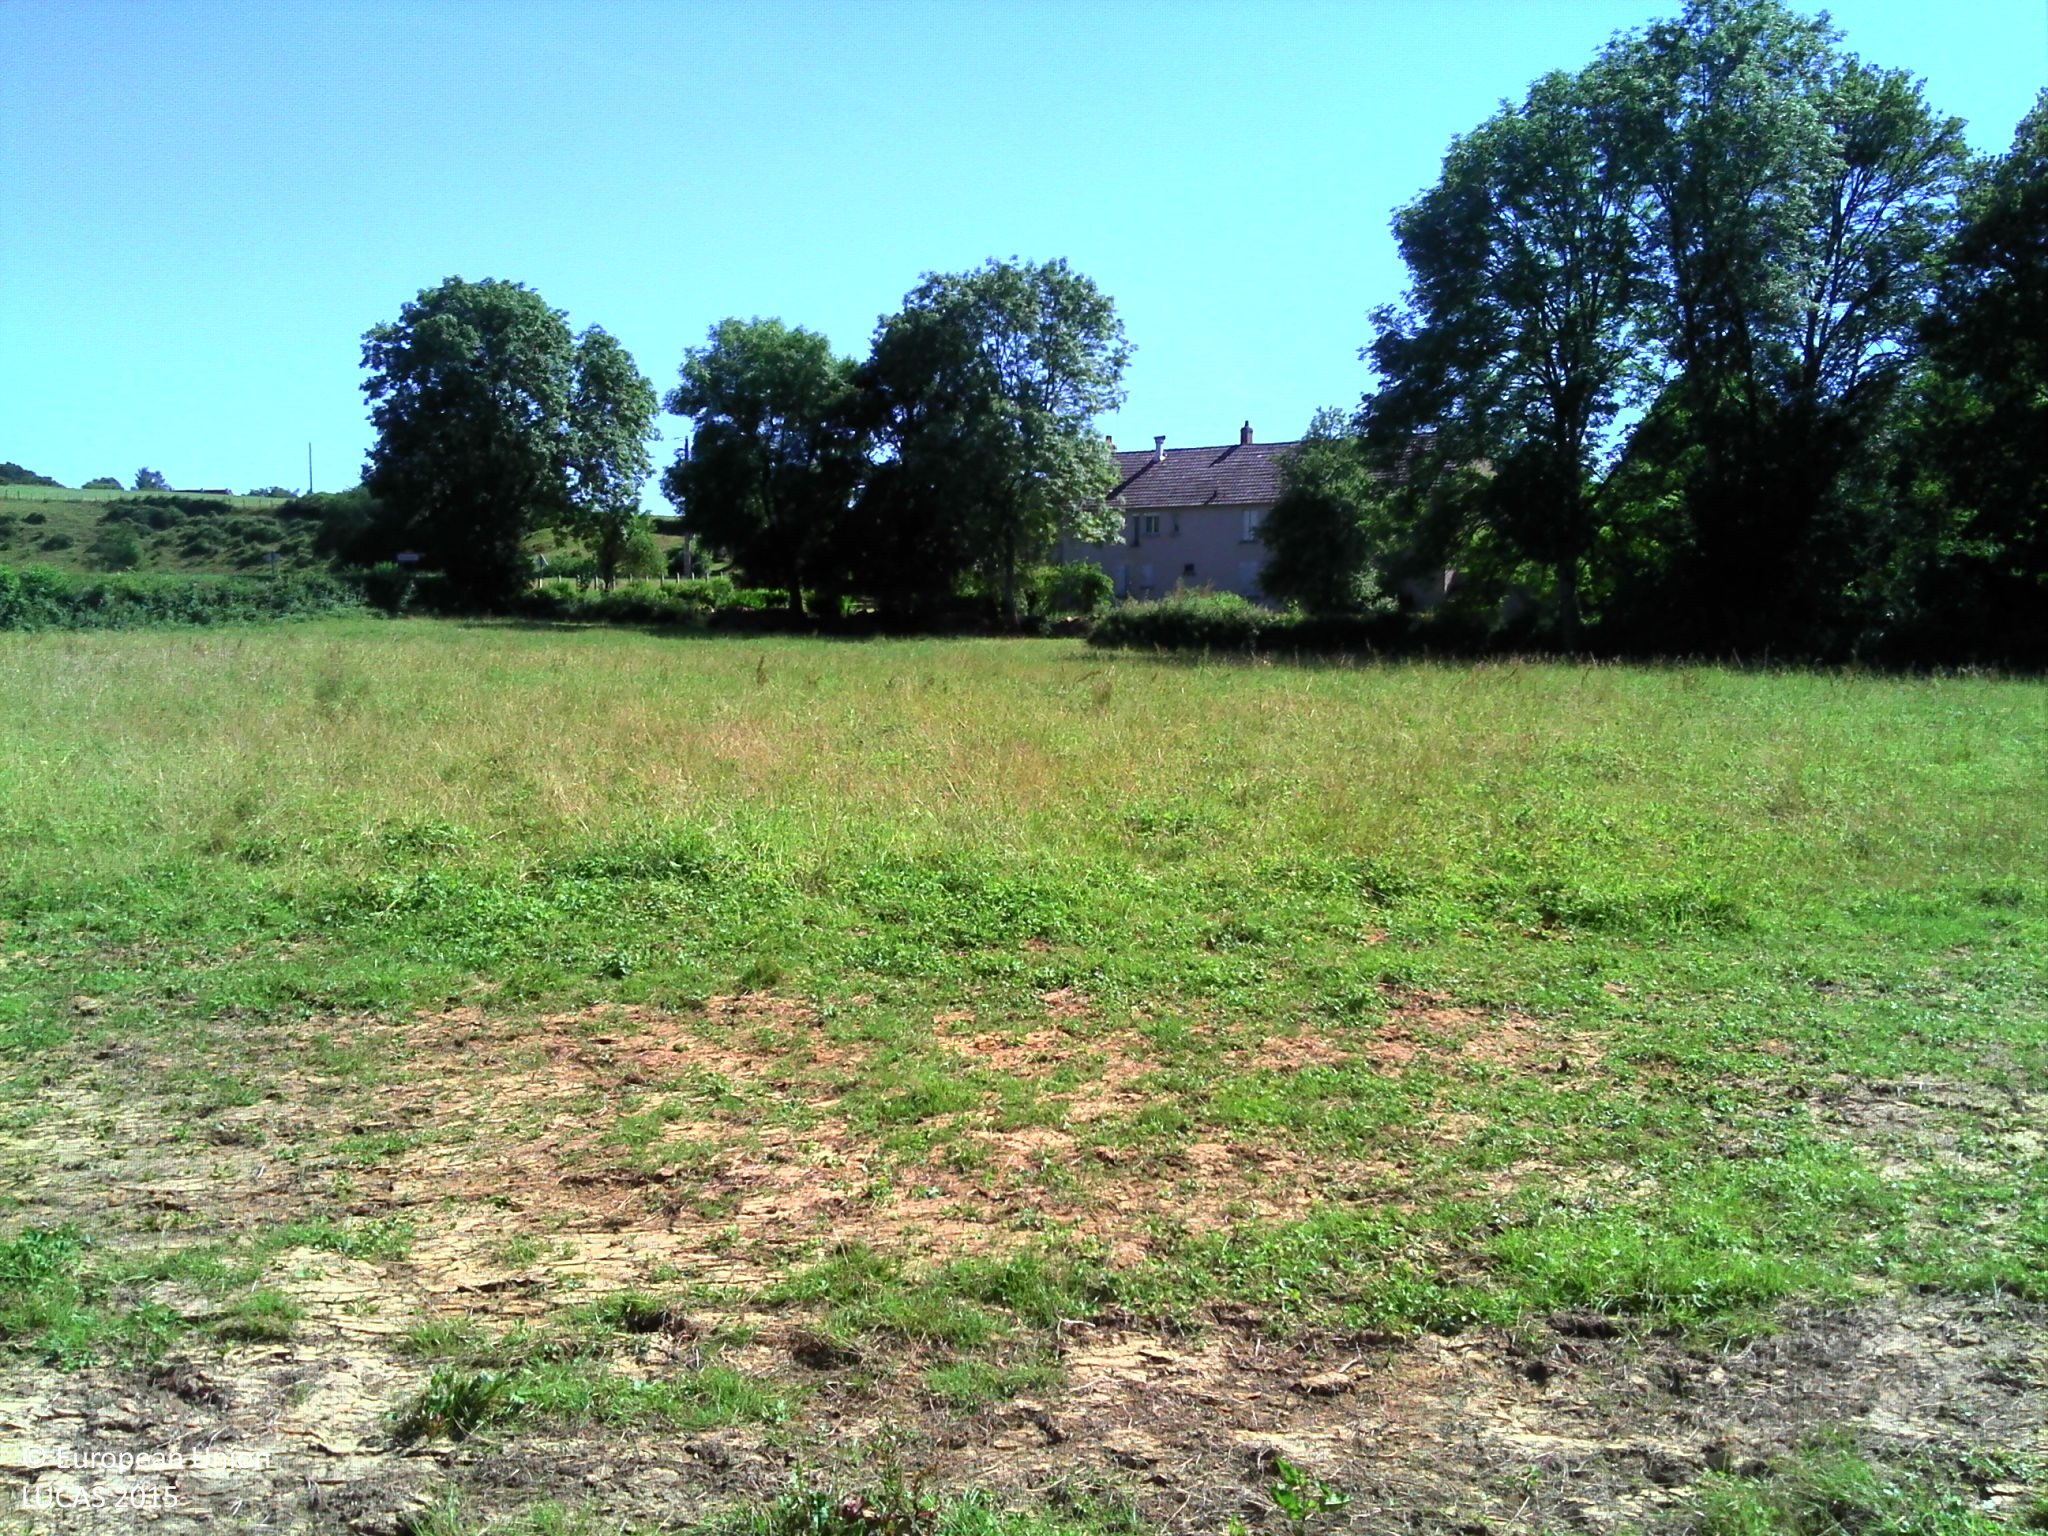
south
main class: Grassland
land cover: Grassland without tree/shrub cover
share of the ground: > 75 %
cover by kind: herbaceous plants 100 %
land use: Agriculture (excluding fallow land and kitchen gardens)
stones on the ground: < 10 %
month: June
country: FR
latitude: 47.3634
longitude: 3.4952
